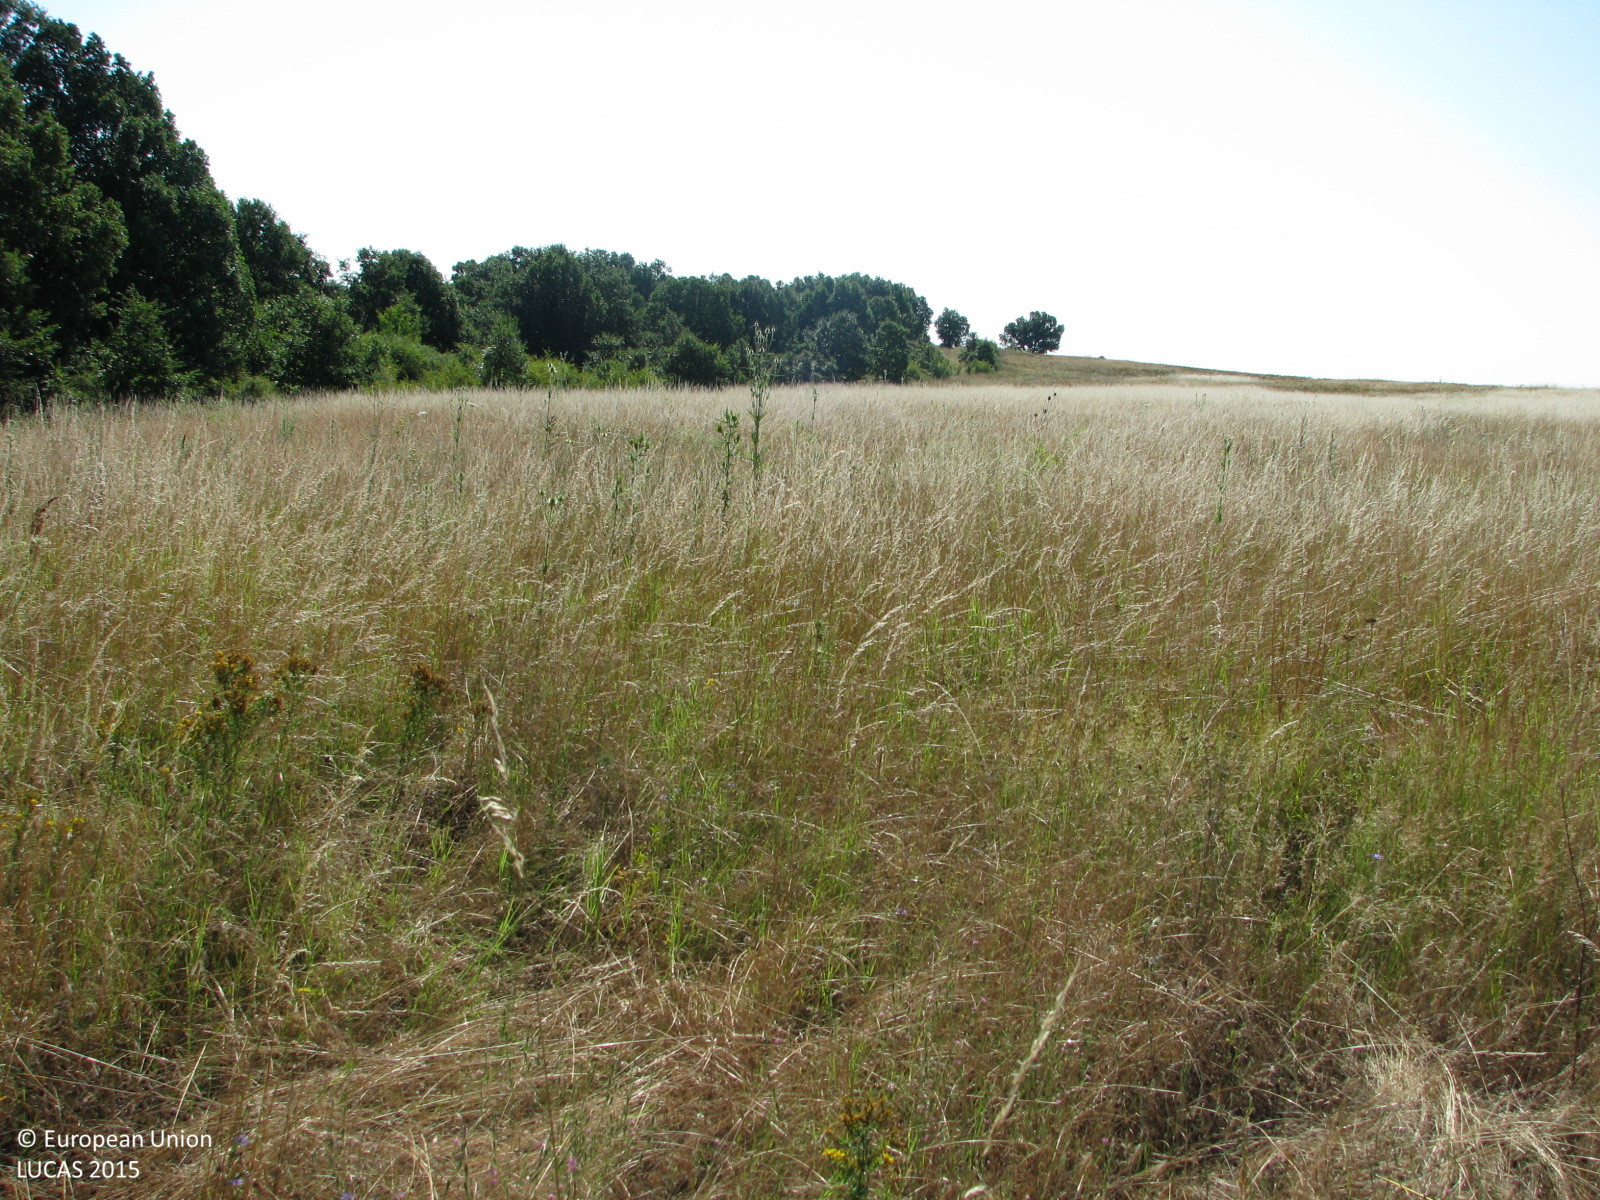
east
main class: Woodland
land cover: Broadleaved woodland
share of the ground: 25 - 50 %
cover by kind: herbaceous plants 50 %, broadleaved forest trees 40 %, shrubs 10 %
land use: Forestry
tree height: < 5 m
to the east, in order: Broadleaved woodland; Grassland without tree/shrub cover; Tracks; Grassland with sparse tree/shrub cover; Broadleaved woodland; Tracks; Shrubland with sparse tree cover
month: July
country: BG
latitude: 42.2159
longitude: 26.9002
